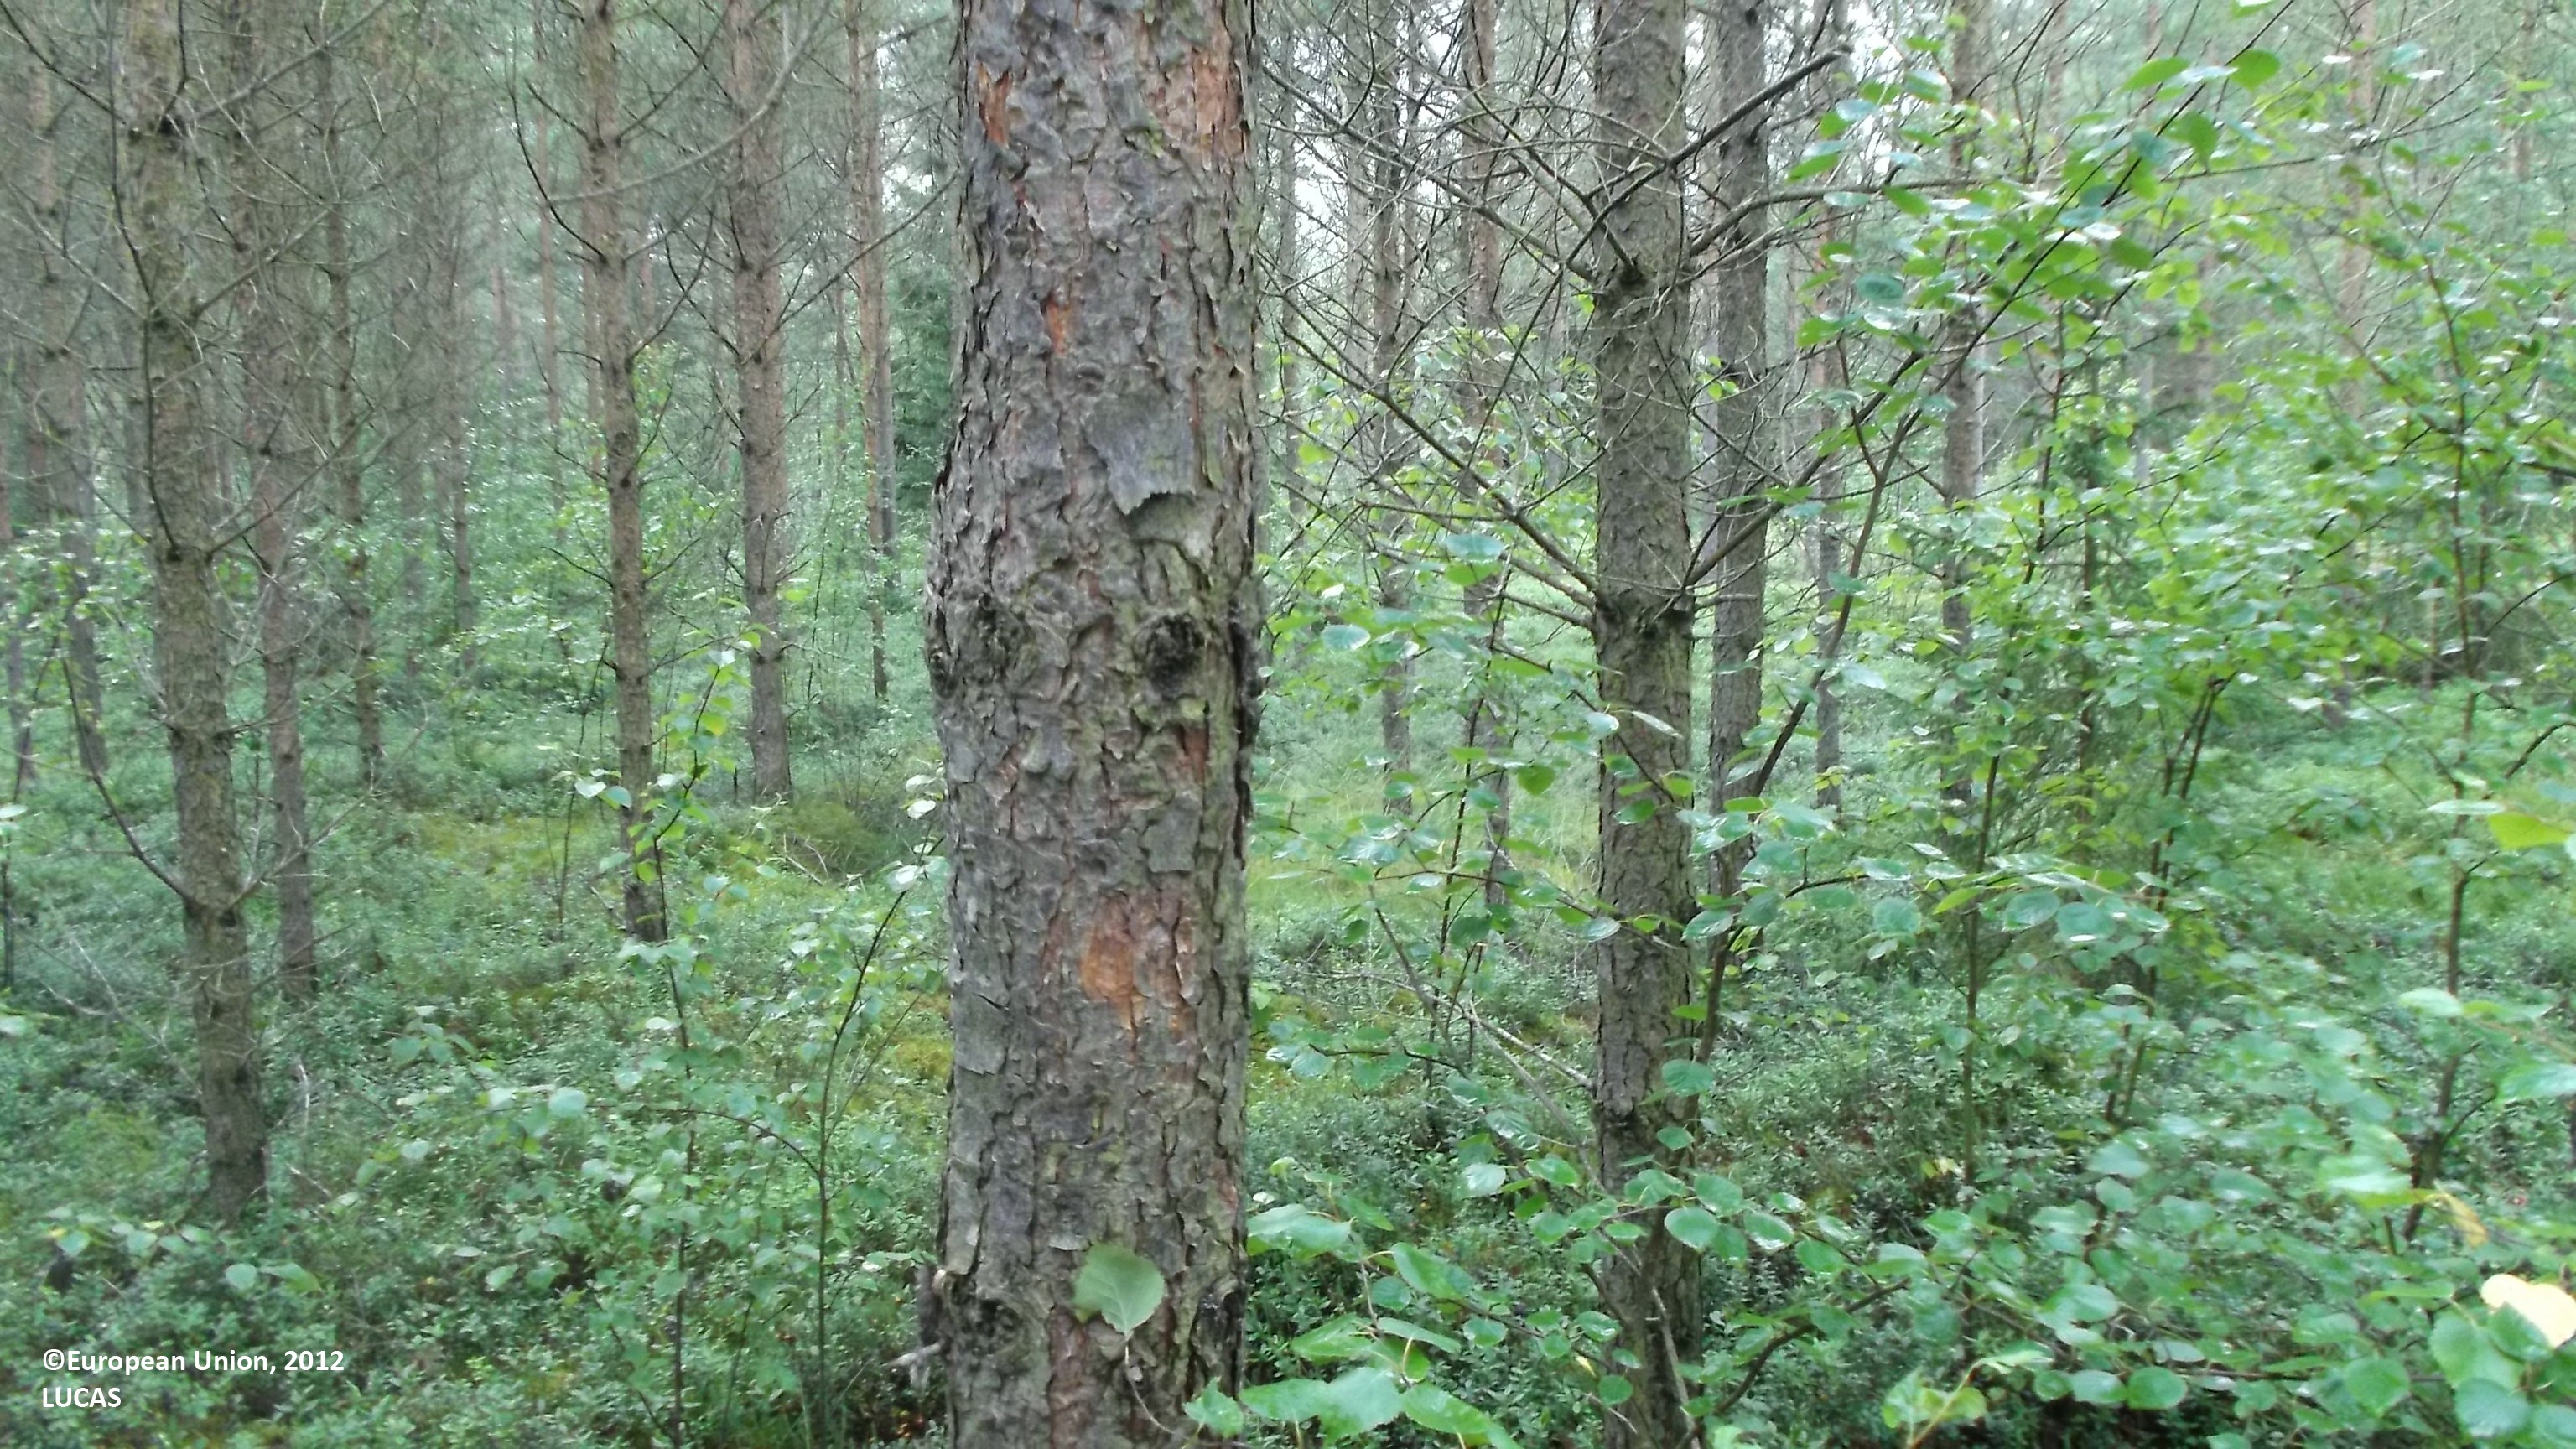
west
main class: Woodland
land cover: Pine dominated mixed woodland
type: boreal forest
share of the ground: 50 - 75 %
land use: Forestry
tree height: > 5 m
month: August
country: FI
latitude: 64.0237
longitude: 23.4595
